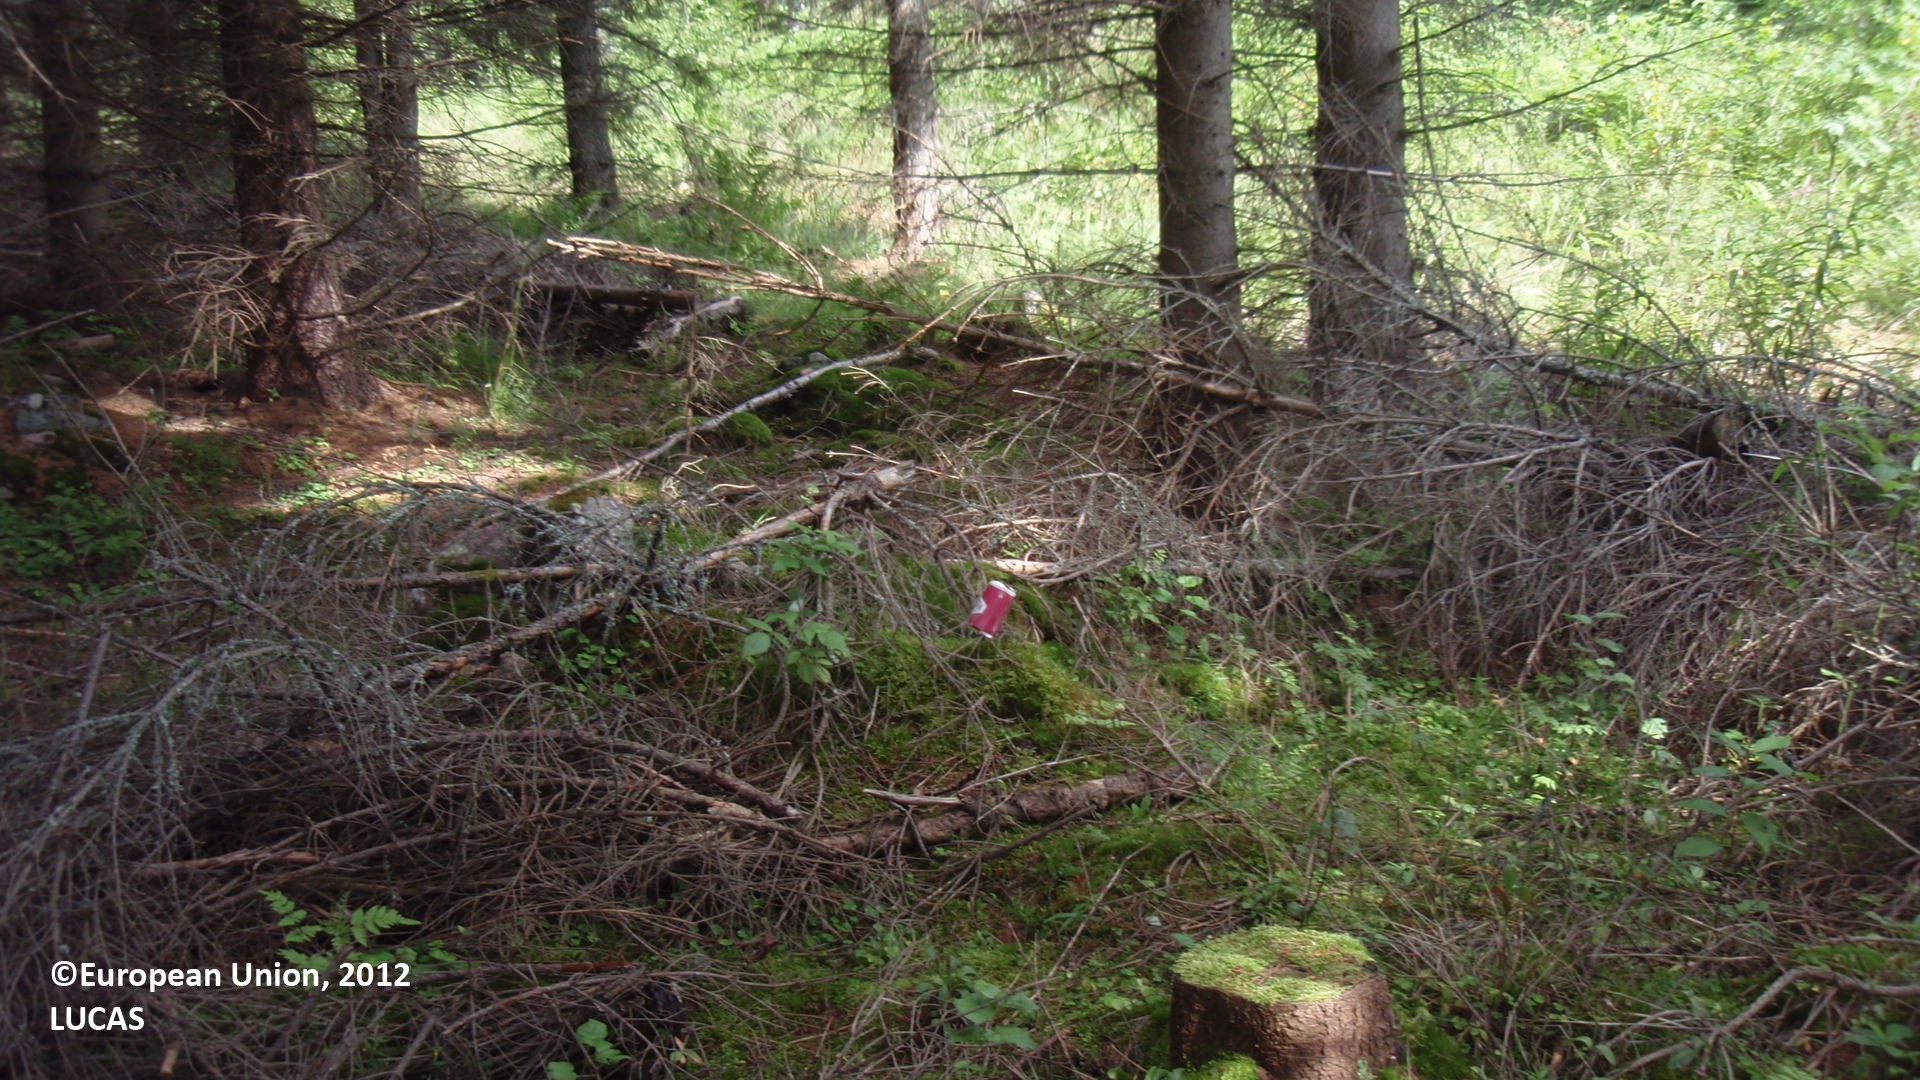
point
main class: Woodland
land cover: Spruce dominated coniferous woodland
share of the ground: 50 - 75 %
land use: Forestry
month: July
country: FI
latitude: 61.3872
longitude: 28.9684
